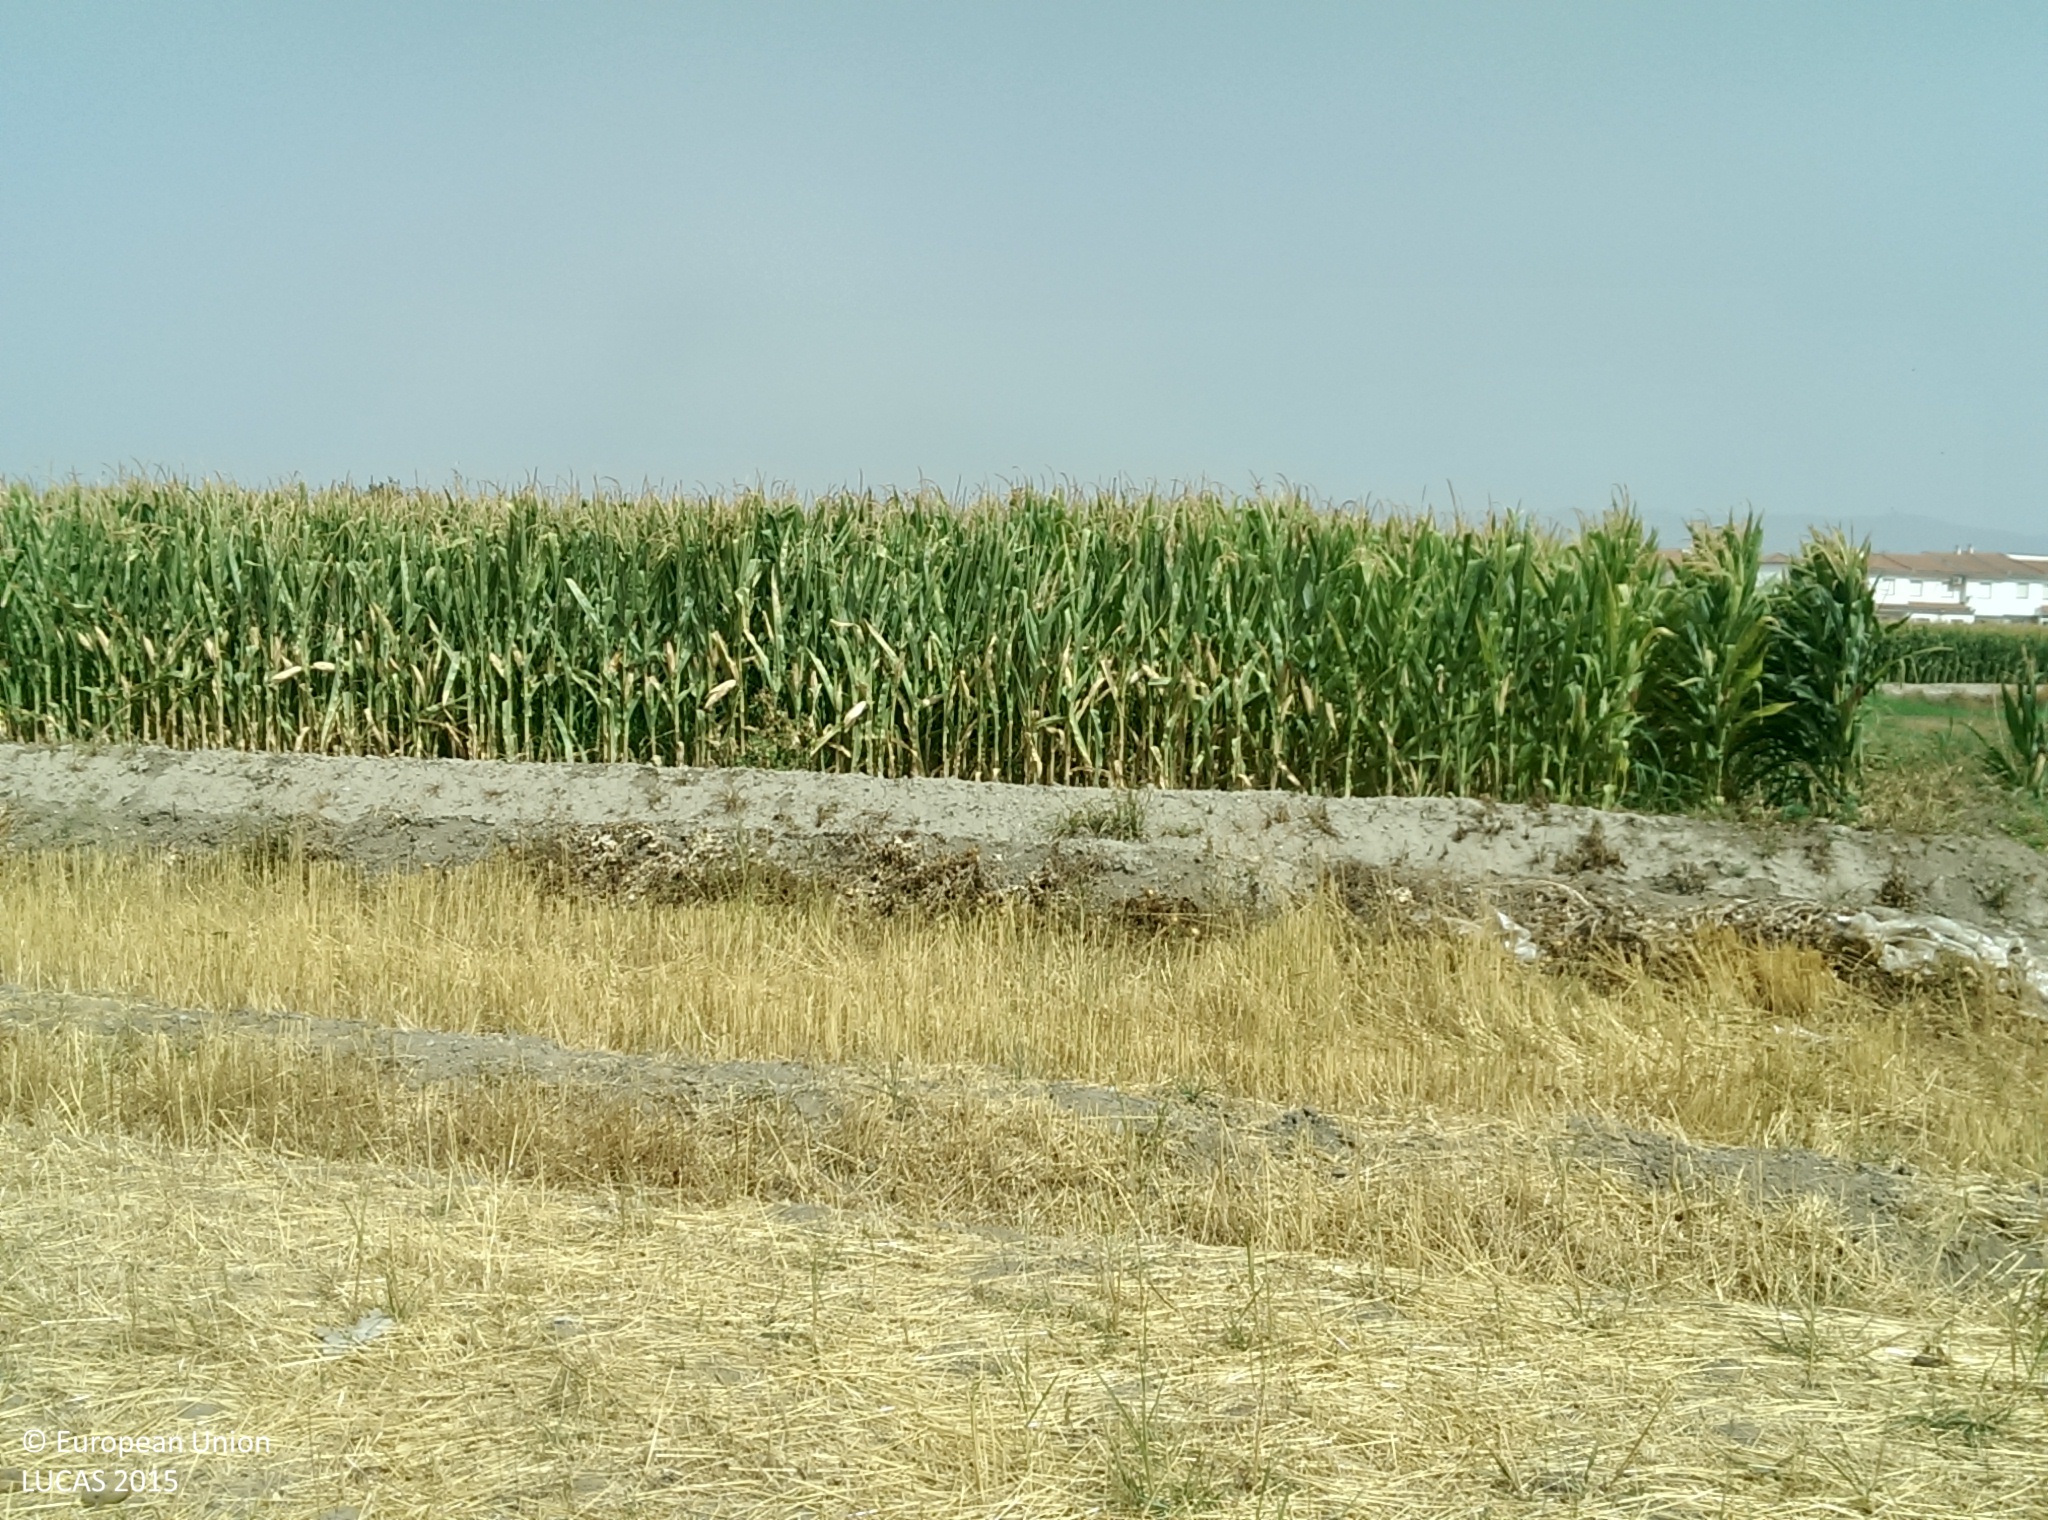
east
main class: Cropland
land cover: Common wheat
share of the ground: < 10 %
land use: Agriculture (excluding fallow land and kitchen gardens)
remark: Harvested field
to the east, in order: Common wheat; Ditches and canals; Maize; Ditches and canals; Maize; Ditches and canals; Grass margins; Tracks; Artificial constructions in urban areas
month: August
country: ES
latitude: 37.1738
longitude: -3.6968
